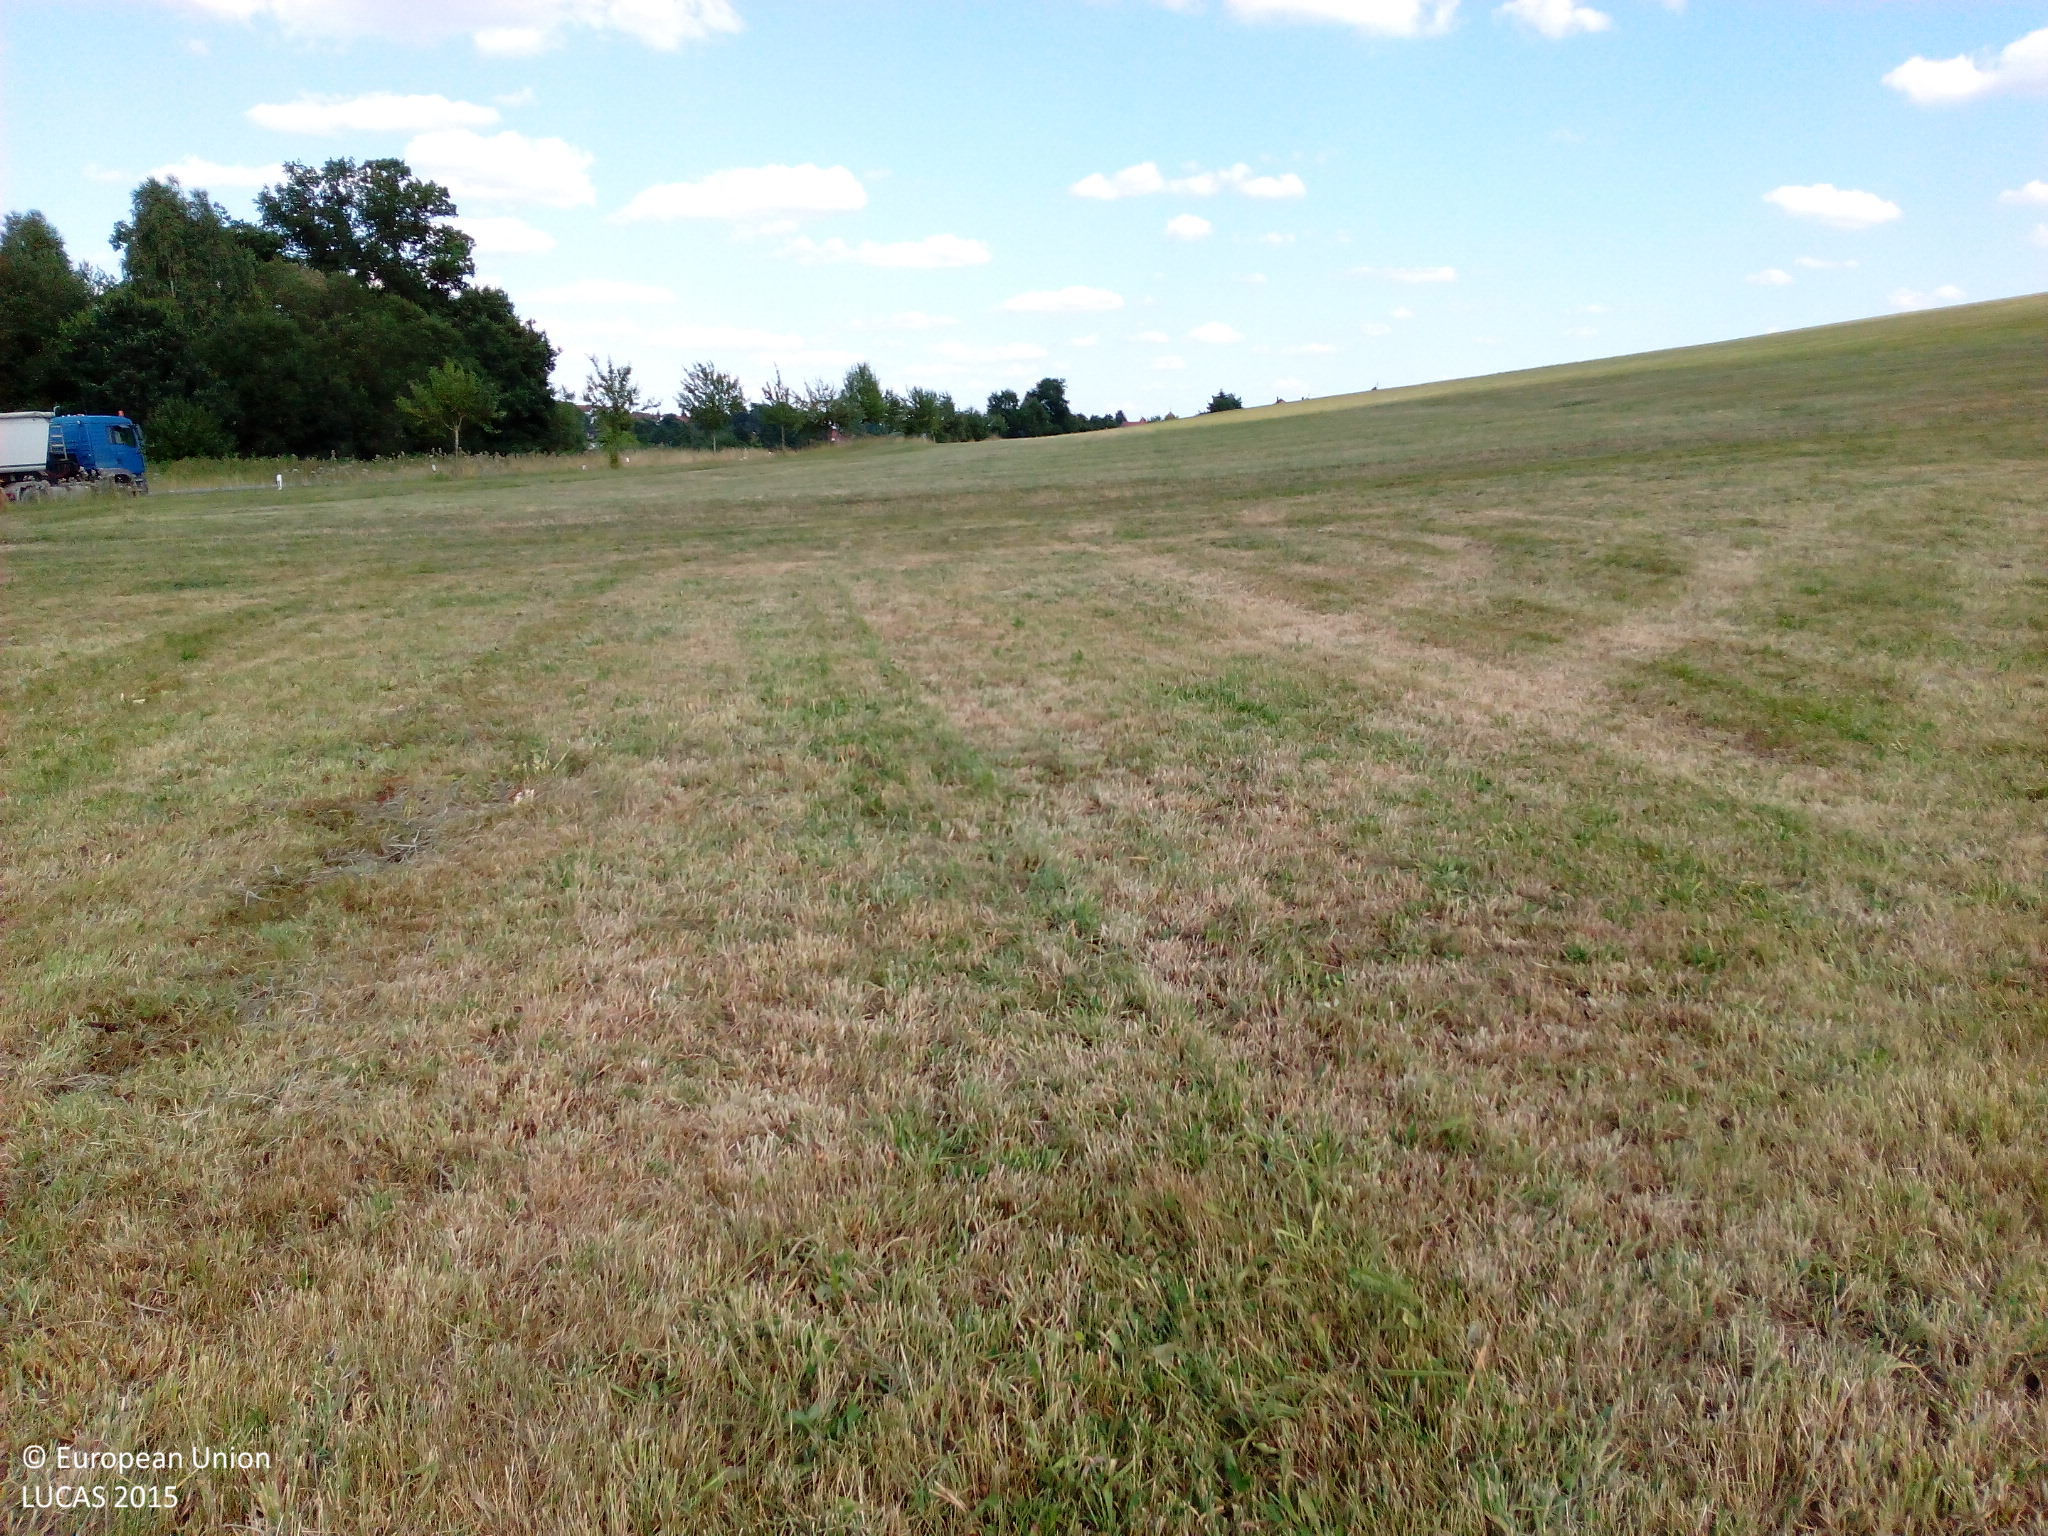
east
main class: Grassland
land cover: Grassland without tree/shrub cover
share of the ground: > 75 %
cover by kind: herbaceous plants 100 %
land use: Agriculture (excluding fallow land and kitchen gardens)
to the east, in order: Grassland without tree/shrub cover; Electric lines; Grassland without tree/shrub cover; Lines of trees; Grass margins; Ditches and canals; Grass margins; Paved roads, cycling and walking lanes; Grass margins; Fences; Grassland without tree/shrub cover; Ditches and canals; Spontaneously vegetated surfaces
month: August
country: DE
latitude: 49.0329
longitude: 10.2598
